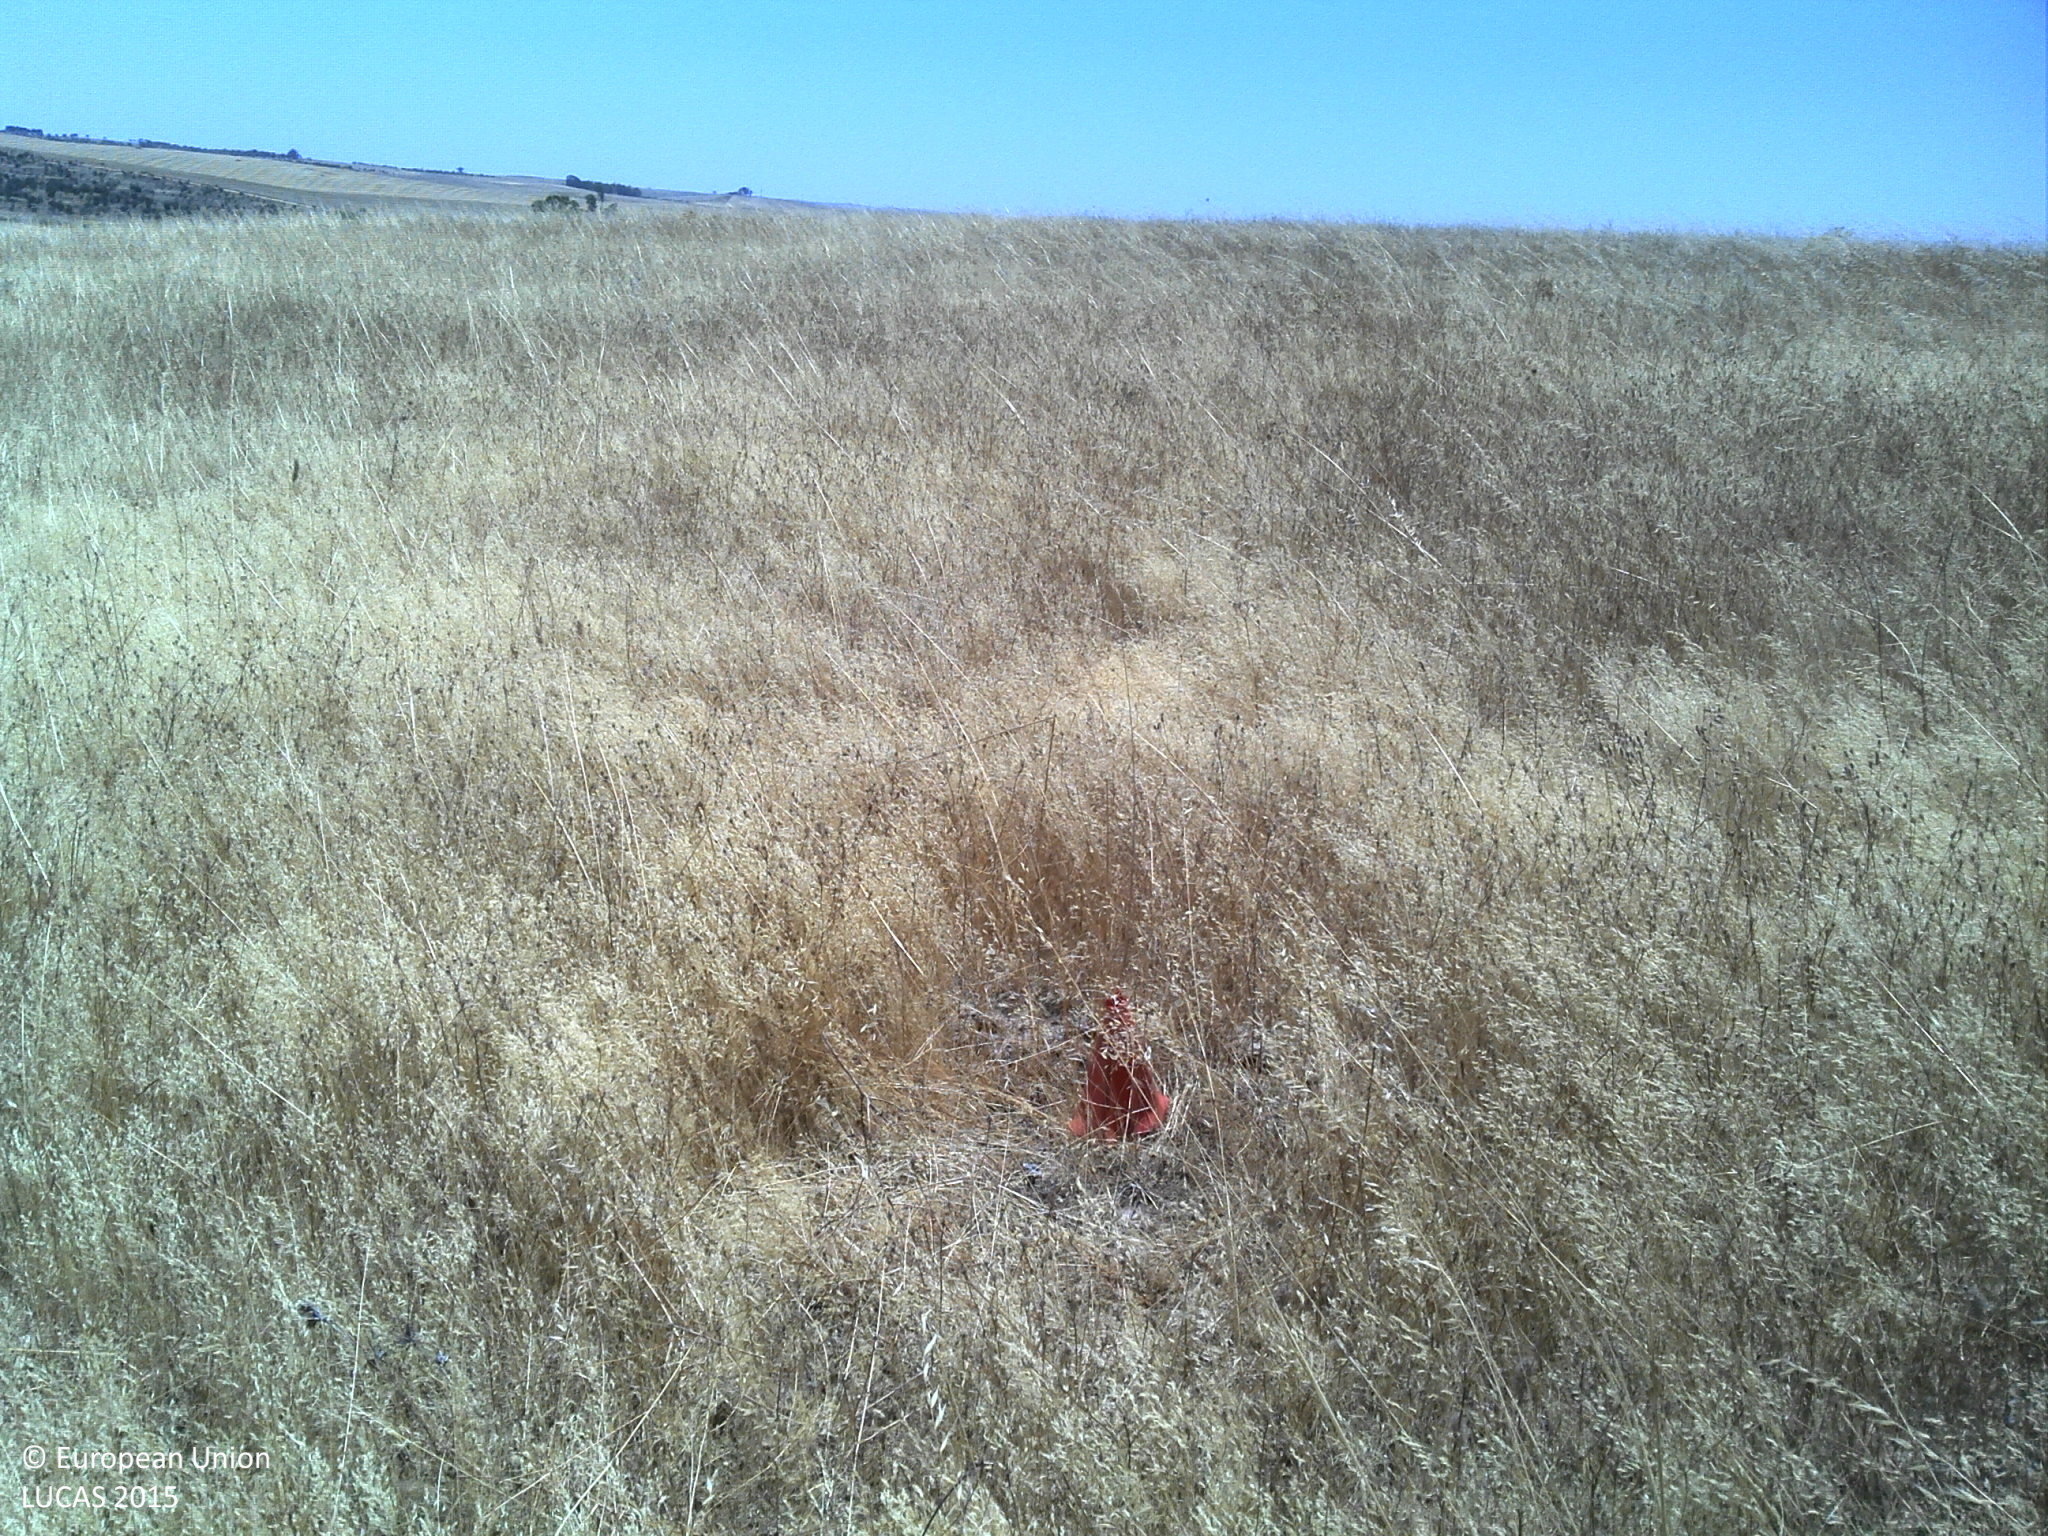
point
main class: Grassland
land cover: Grassland without tree/shrub cover
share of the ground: > 75 %
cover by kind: herbaceous plants 100 %
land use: Agriculture (excluding fallow land and kitchen gardens)
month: July
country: PT
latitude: 37.7912
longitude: -8.0027
